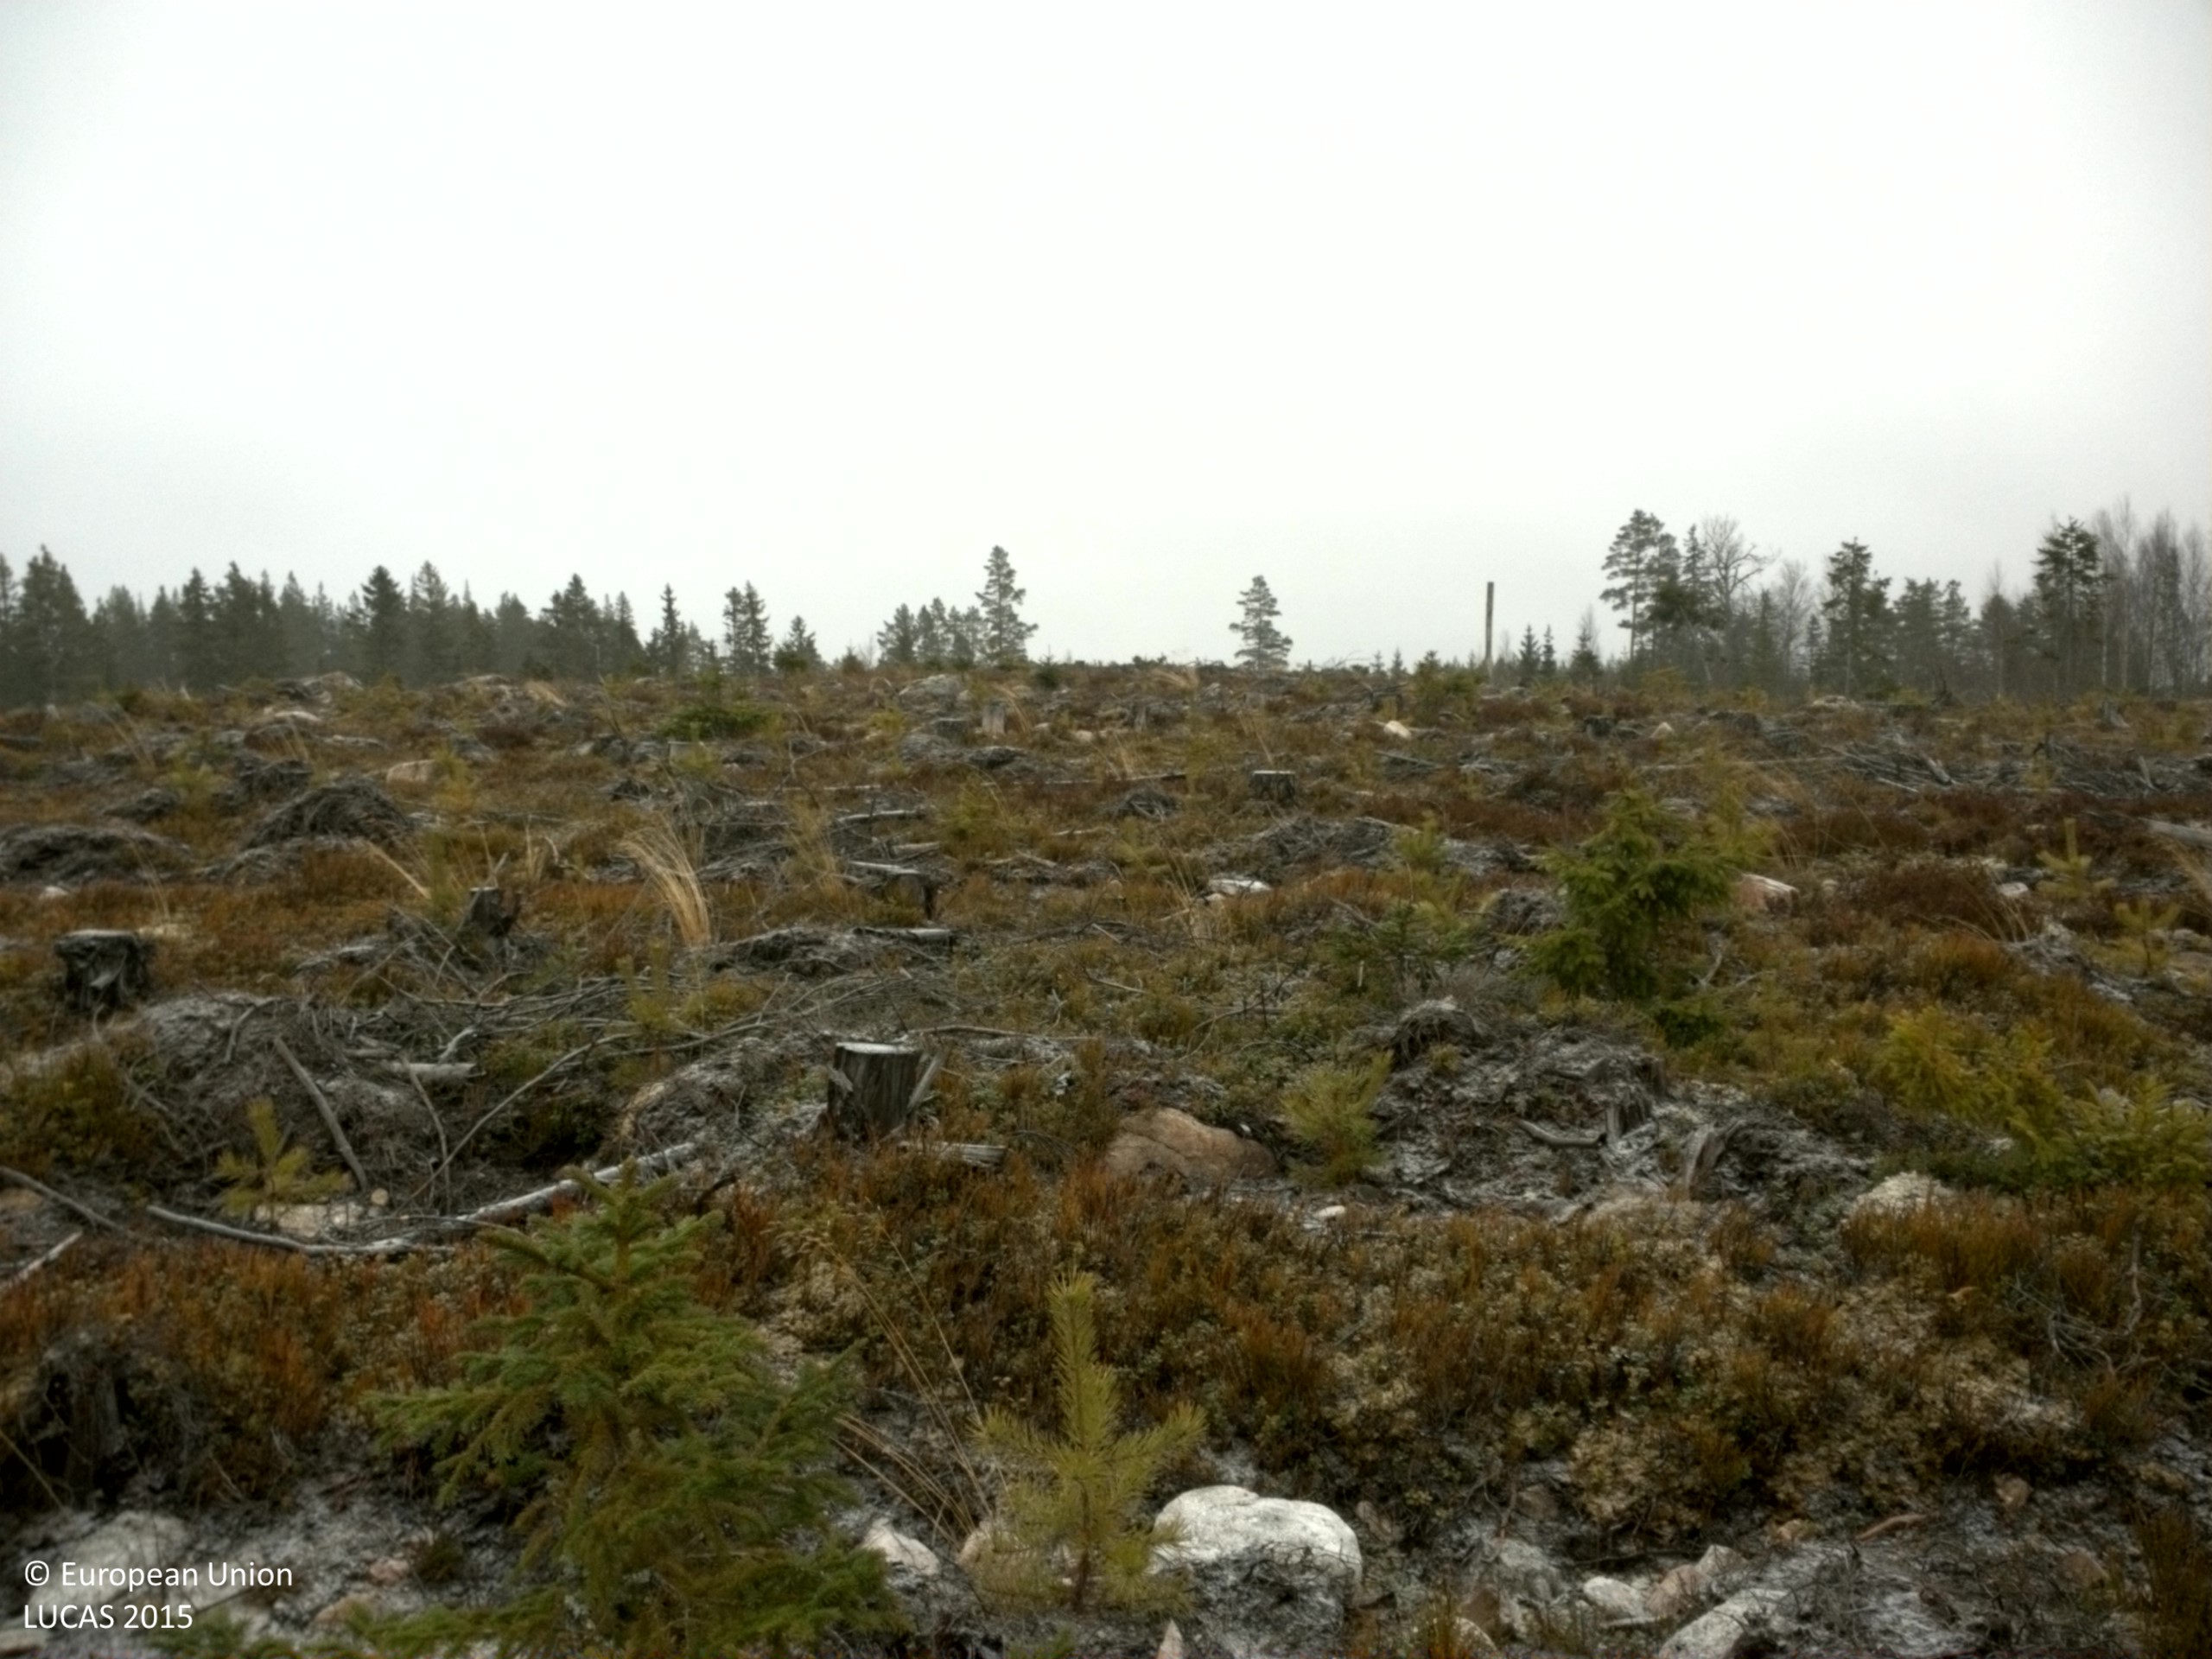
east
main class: Shrubland
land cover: Shrubland with sparse tree cover
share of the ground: 50 - 75 %
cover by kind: shrubs 40 %, herbaceous plants 30 %, lichens and mosses 20 %, coniferous forest trees 5 %, consolidated bare surface 5 %
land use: Forestry
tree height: < 5 m
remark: Clear cut
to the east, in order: Shrubland with sparse tree cover; Ditches and canals; Paved roads, cycling and walking lanes; Ditches and canals; Spruce dominated mixed woodland; Pine dominated coniferous woodland; Spruce dominated coniferous woodland; Pine dominated coniferous woodland
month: November
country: SE
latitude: 61.0494
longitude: 15.9305
